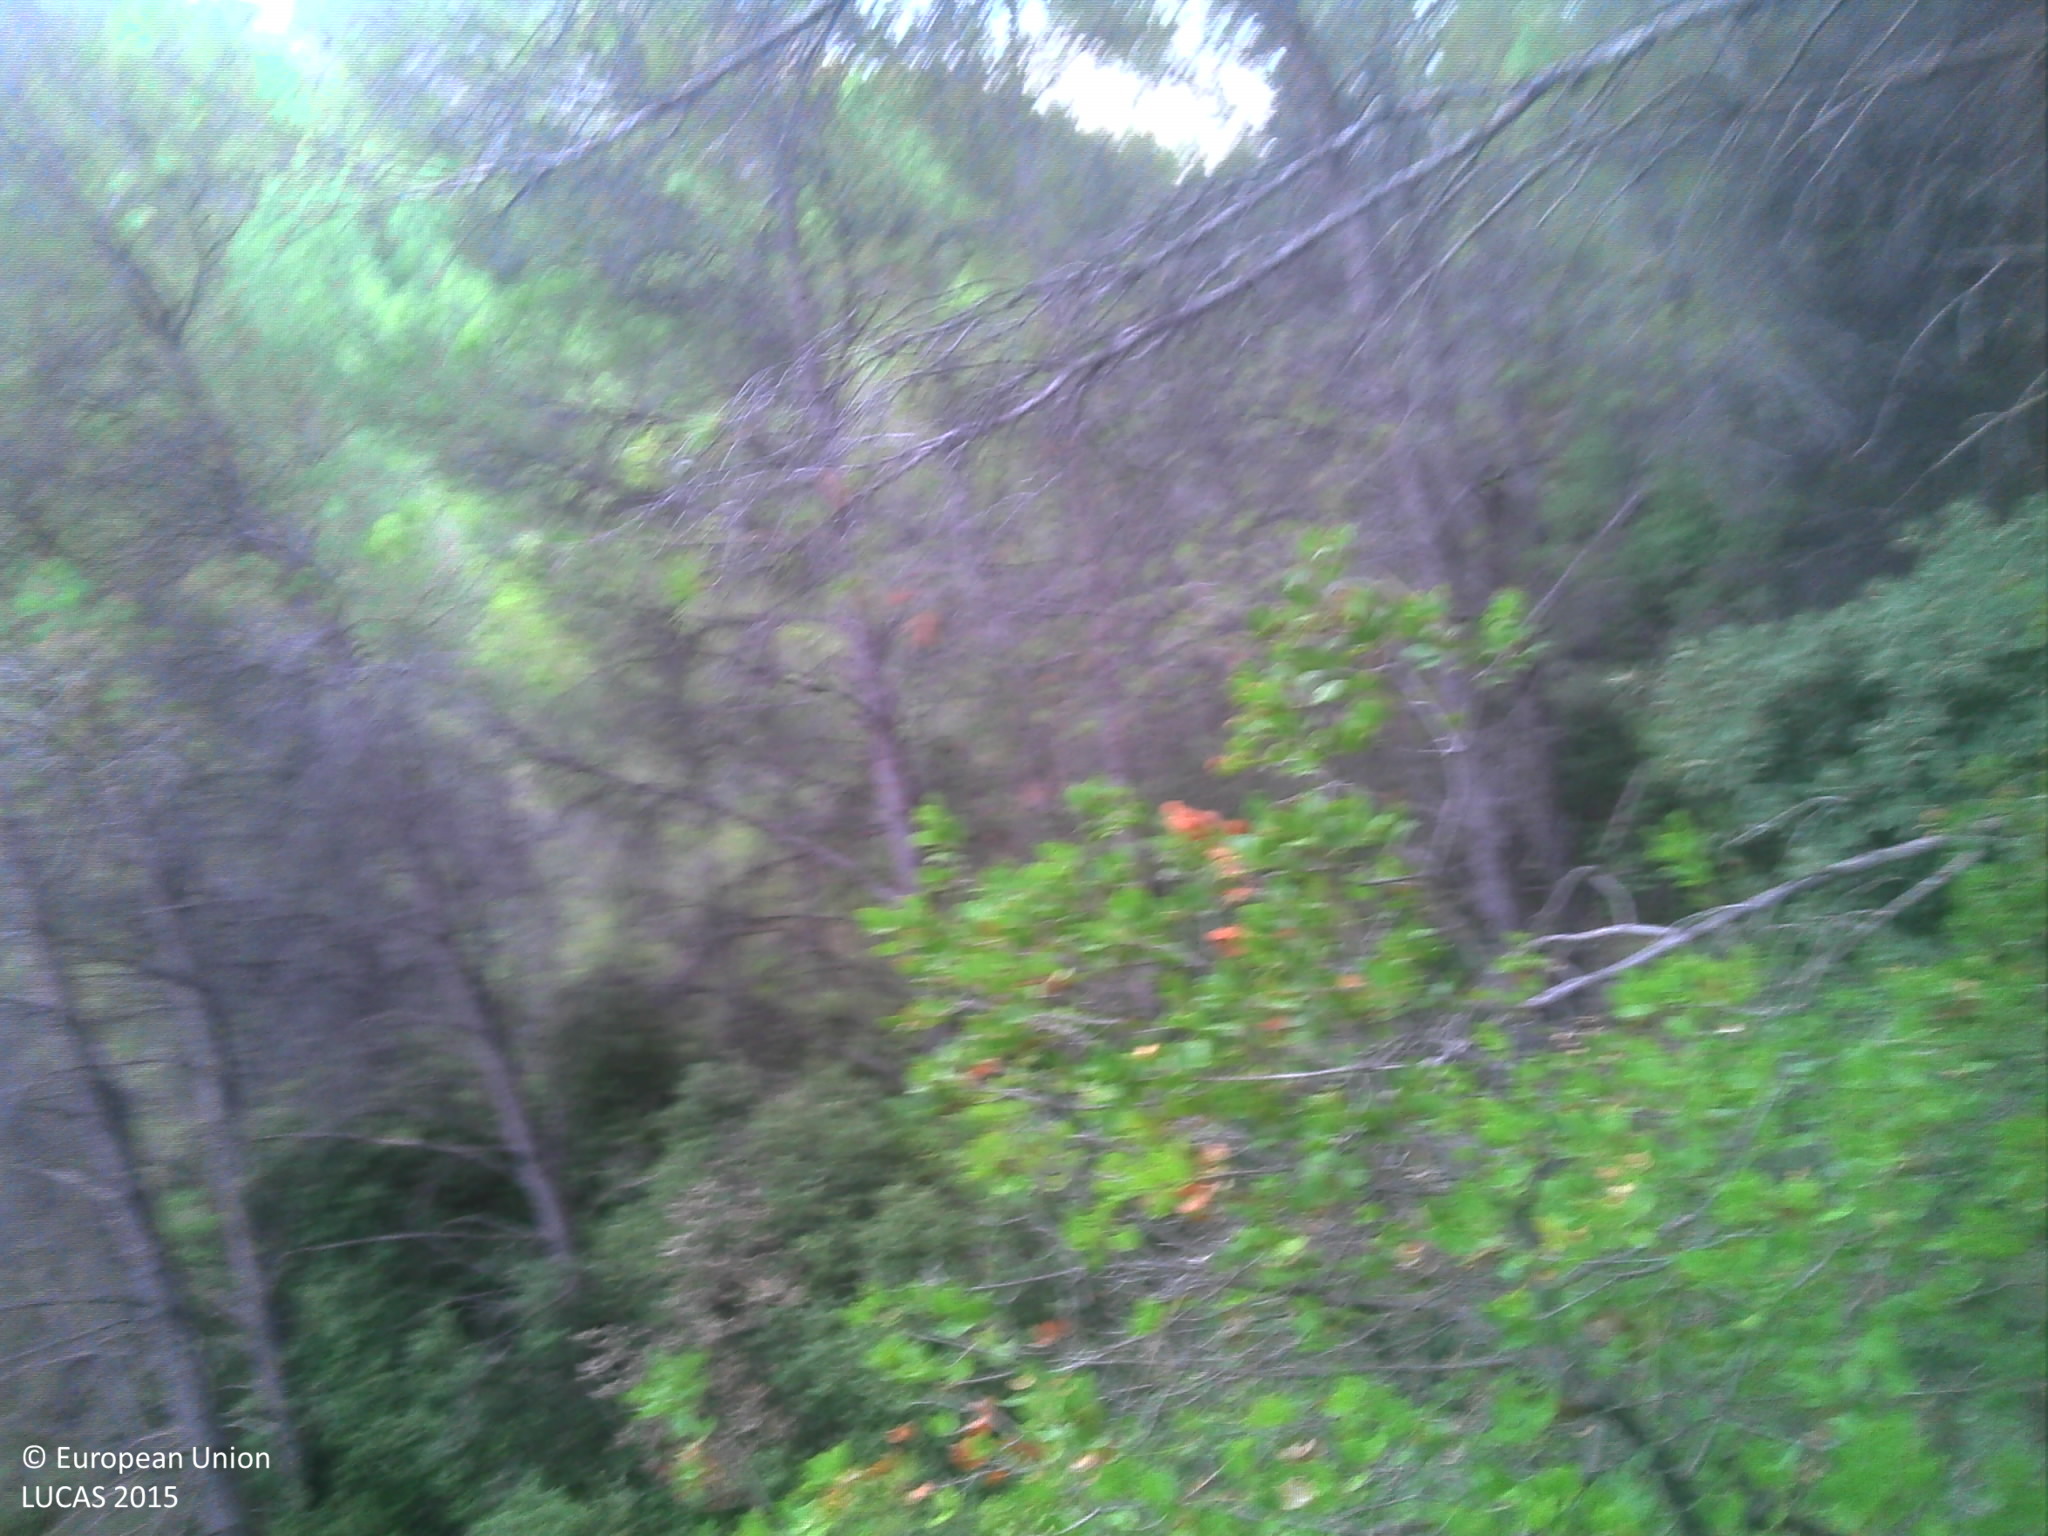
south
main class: Woodland
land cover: Pine dominated coniferous woodland
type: coniferous forest of the mediterranean region
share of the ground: > 75 %
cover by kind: coniferous forest trees 60 %, shrubs 20 %, unconsolidated bare surface 15 %, herbaceous plants 5 %
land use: Forestry
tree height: > 5 m
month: August
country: FR
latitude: 43.3563
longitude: 5.6546
